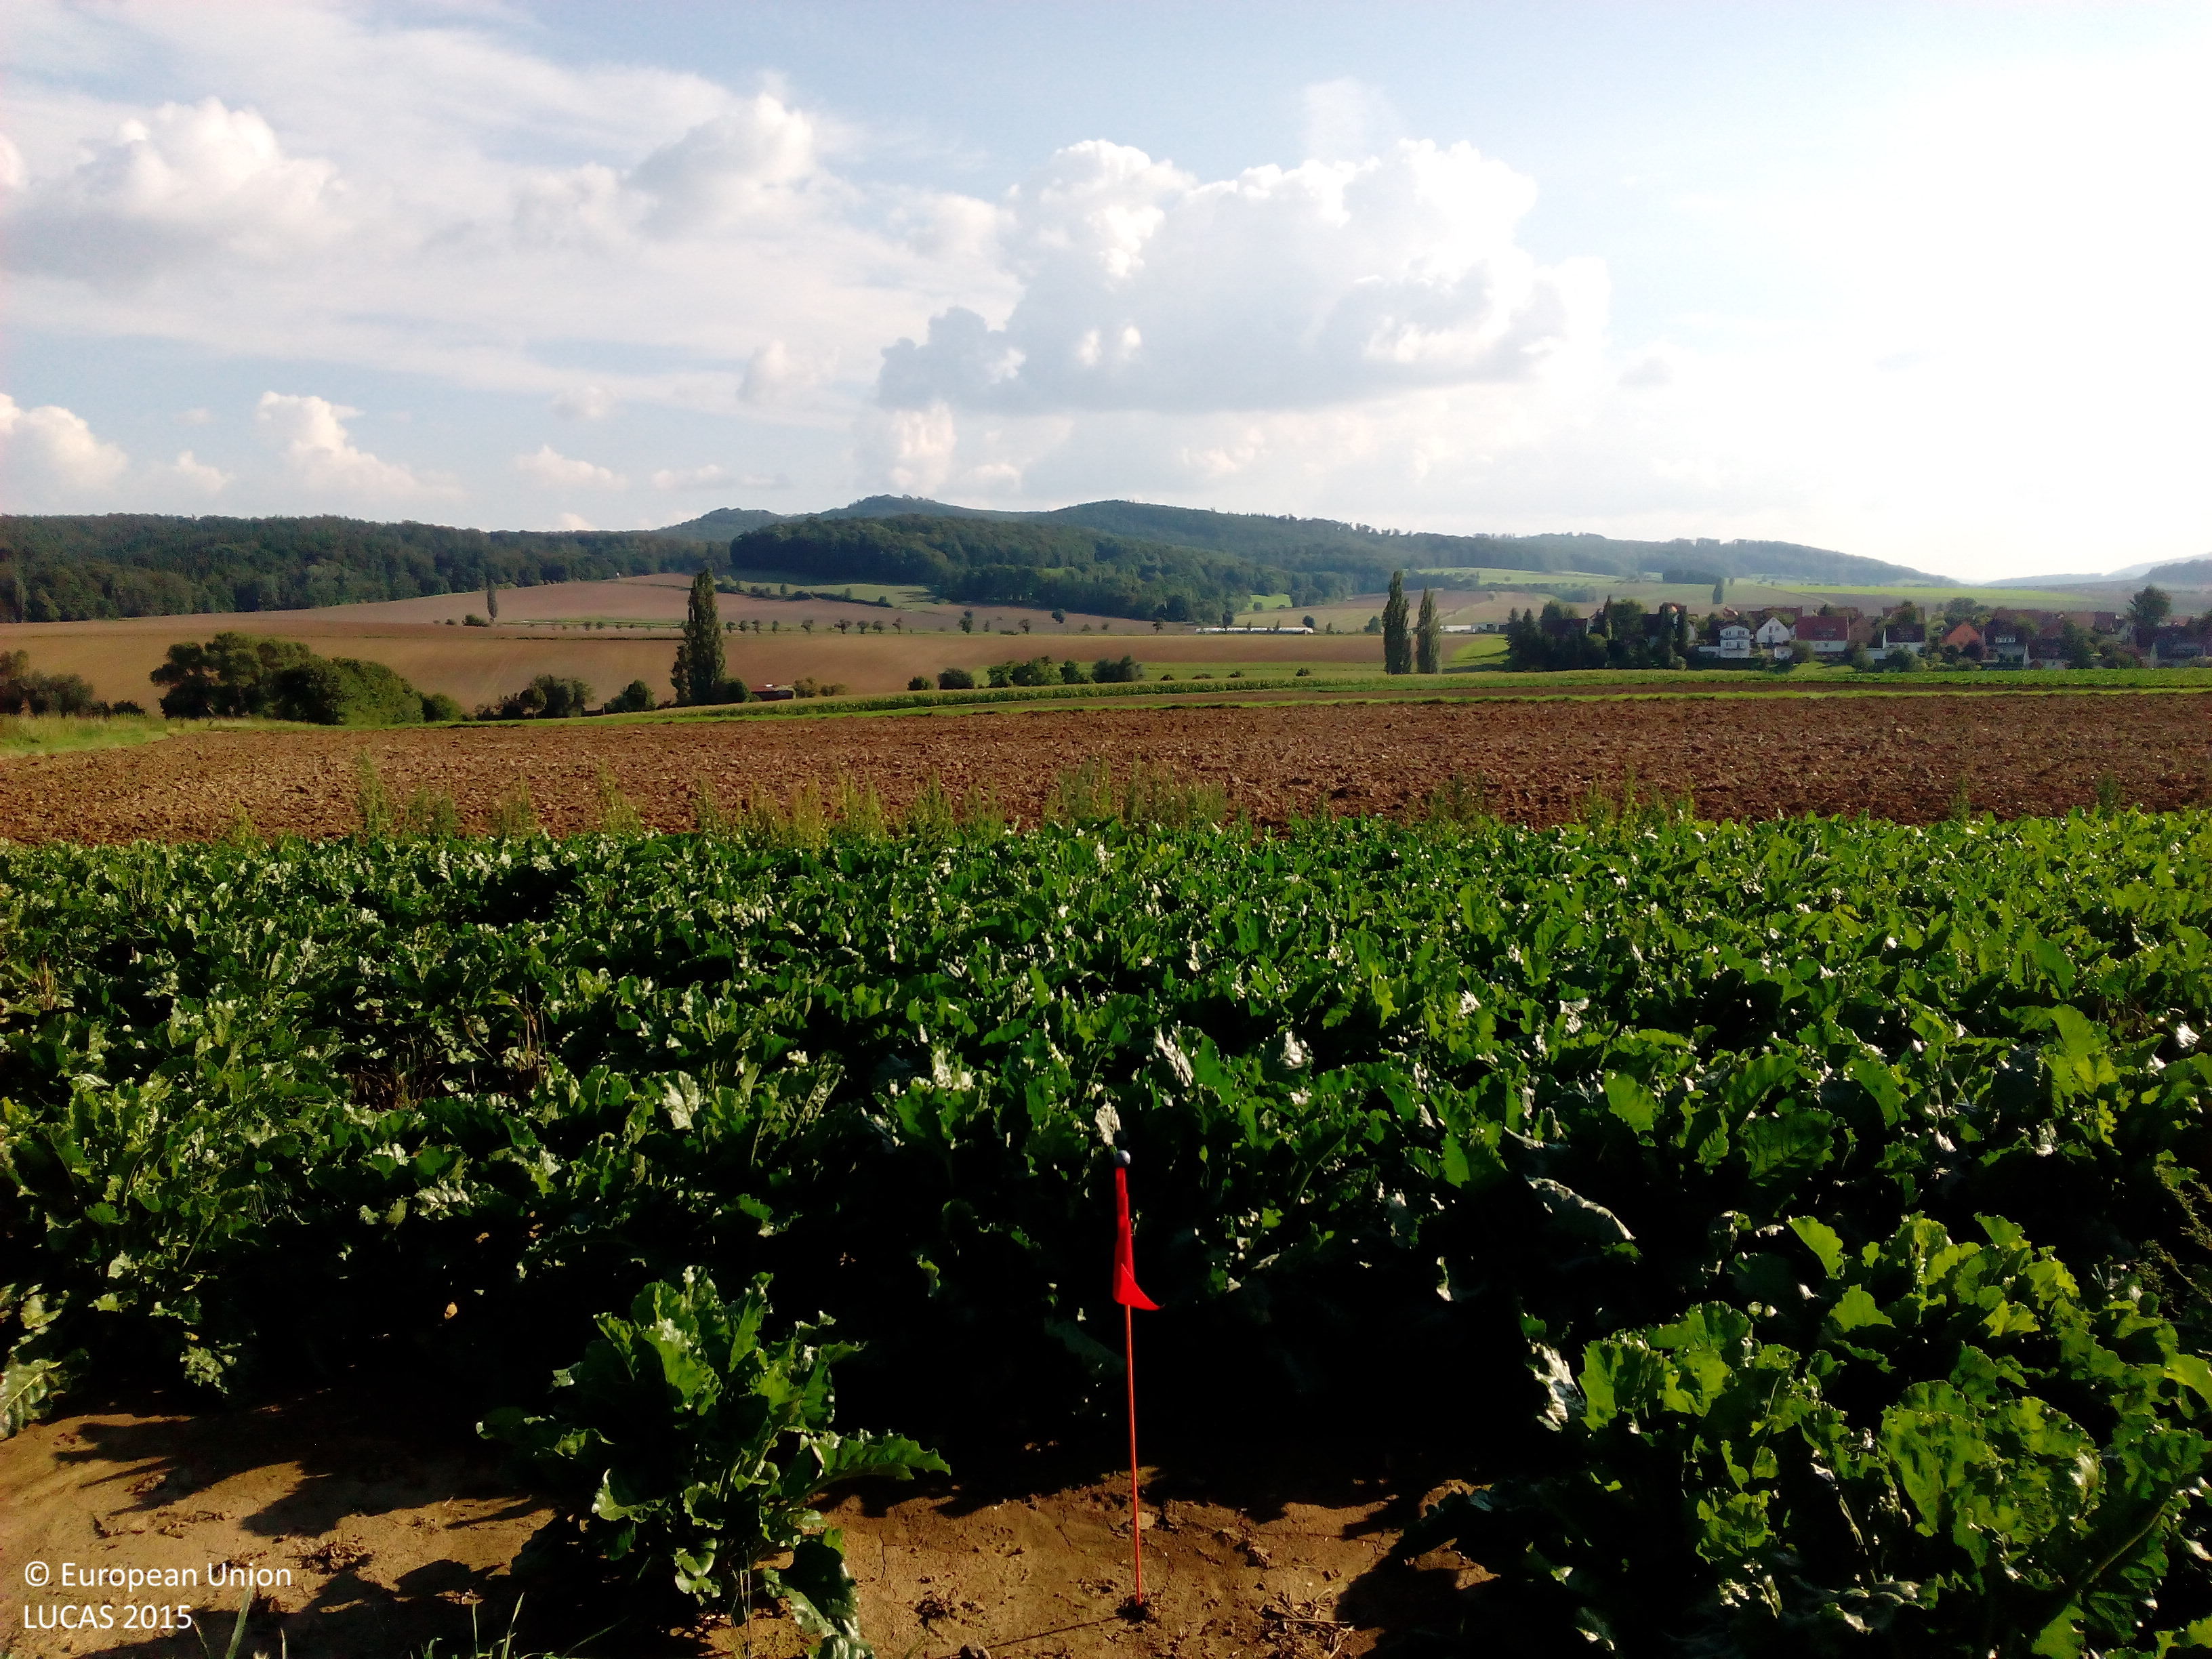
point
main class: Cropland
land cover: Sugar beet
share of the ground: > 75 %
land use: Agriculture (excluding fallow land and kitchen gardens)
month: September
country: DE
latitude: 51.4607
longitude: 9.9568
